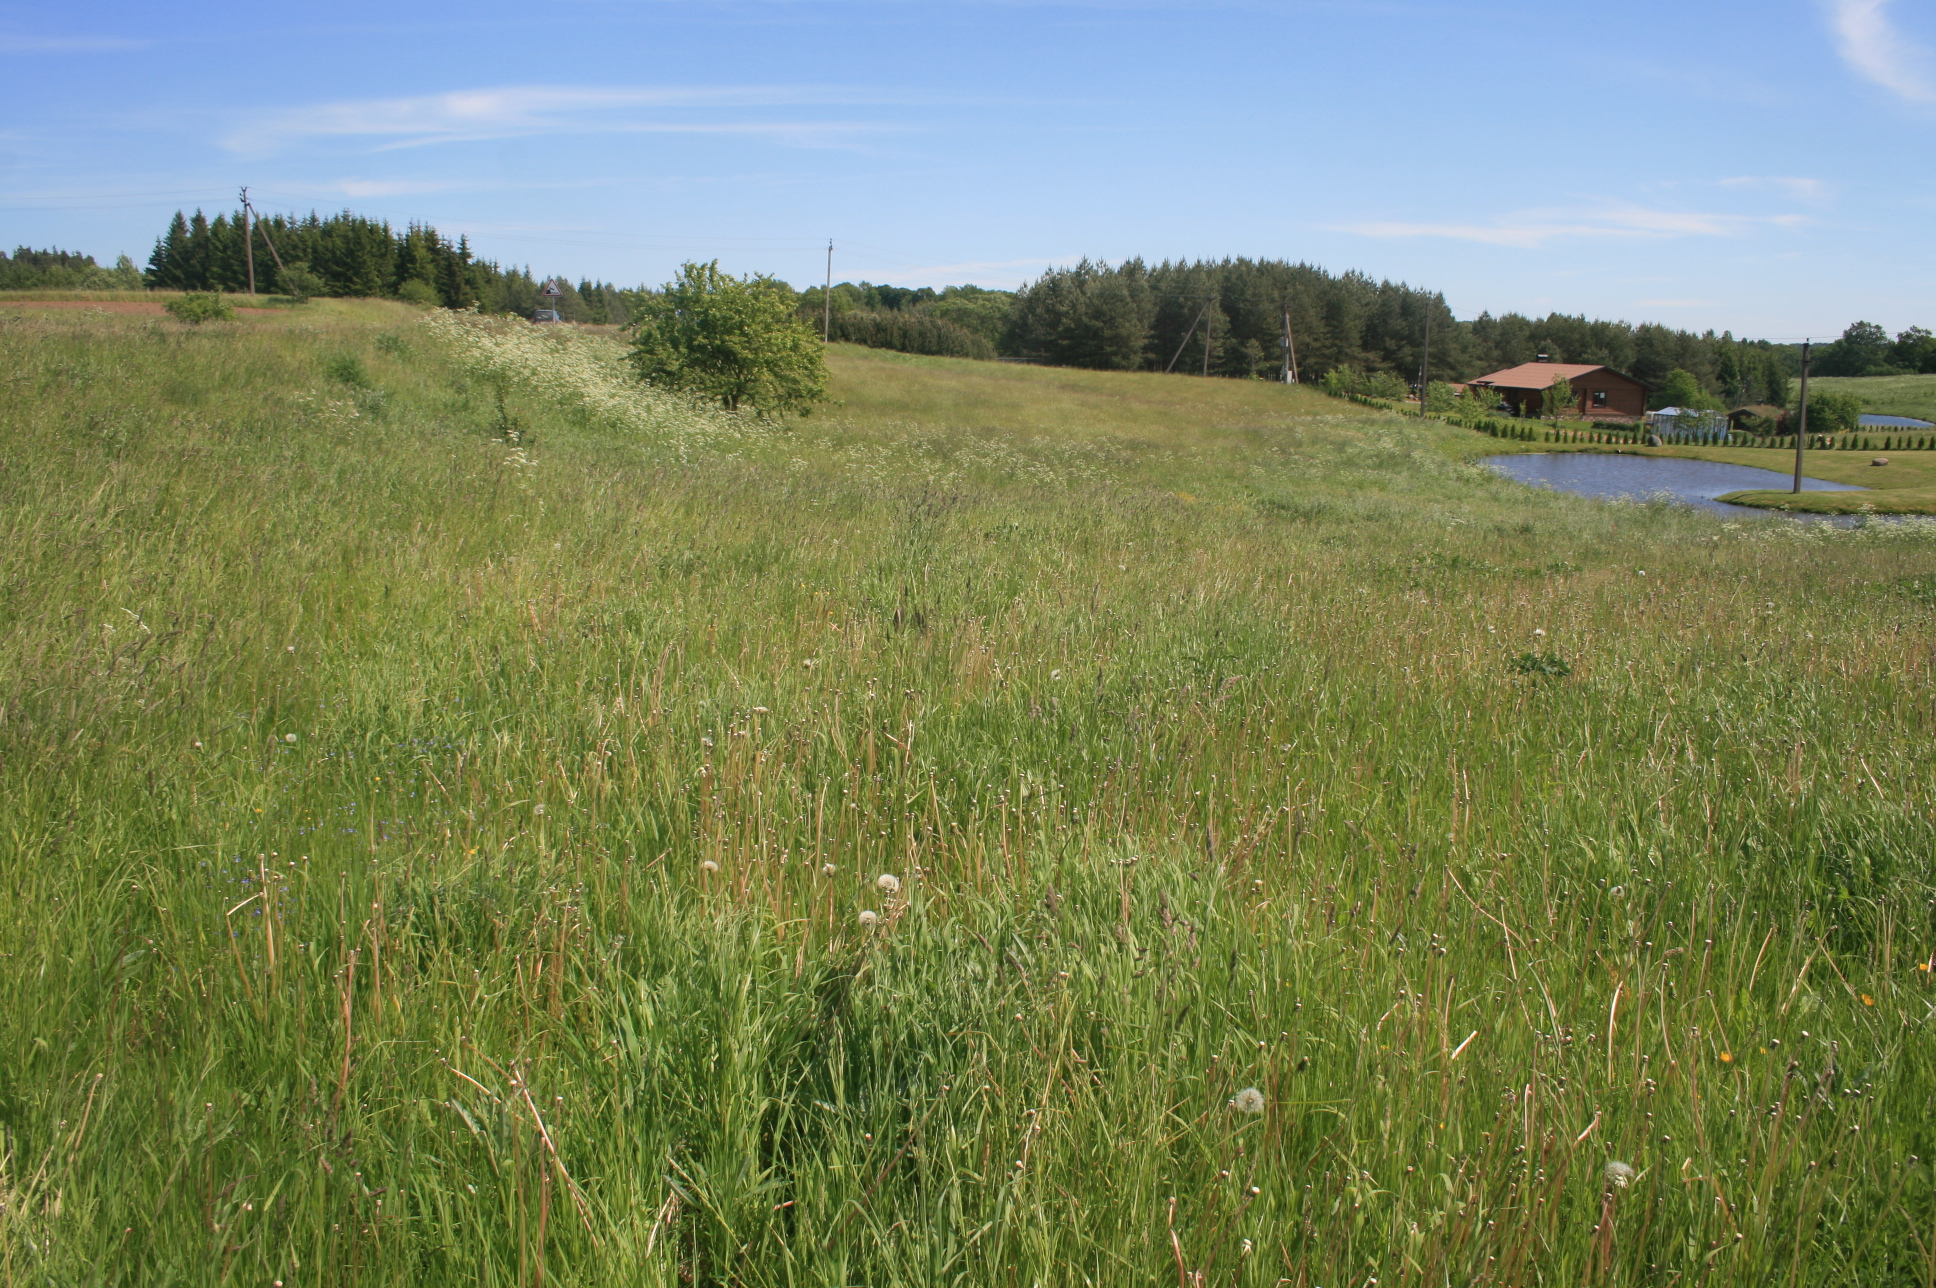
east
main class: Grassland
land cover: Grassland without tree/shrub cover
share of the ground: > 75 %
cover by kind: herbaceous plants 100 %
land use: Agriculture (excluding fallow land and kitchen gardens)
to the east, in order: Grassland without tree/shrub cover; Single bushes/trees; Grassland without tree/shrub cover; Single bushes/trees; Grassland without tree/shrub cover; Electric lines; Grass margins; Paved roads, cycling and walking lanes; Lines of trees; Grass margins; Fences; Grassland with sparse tree/shrub cover; Shrubland with sparse tree cover
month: June
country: LT
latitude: 55.9358
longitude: 22.3351
